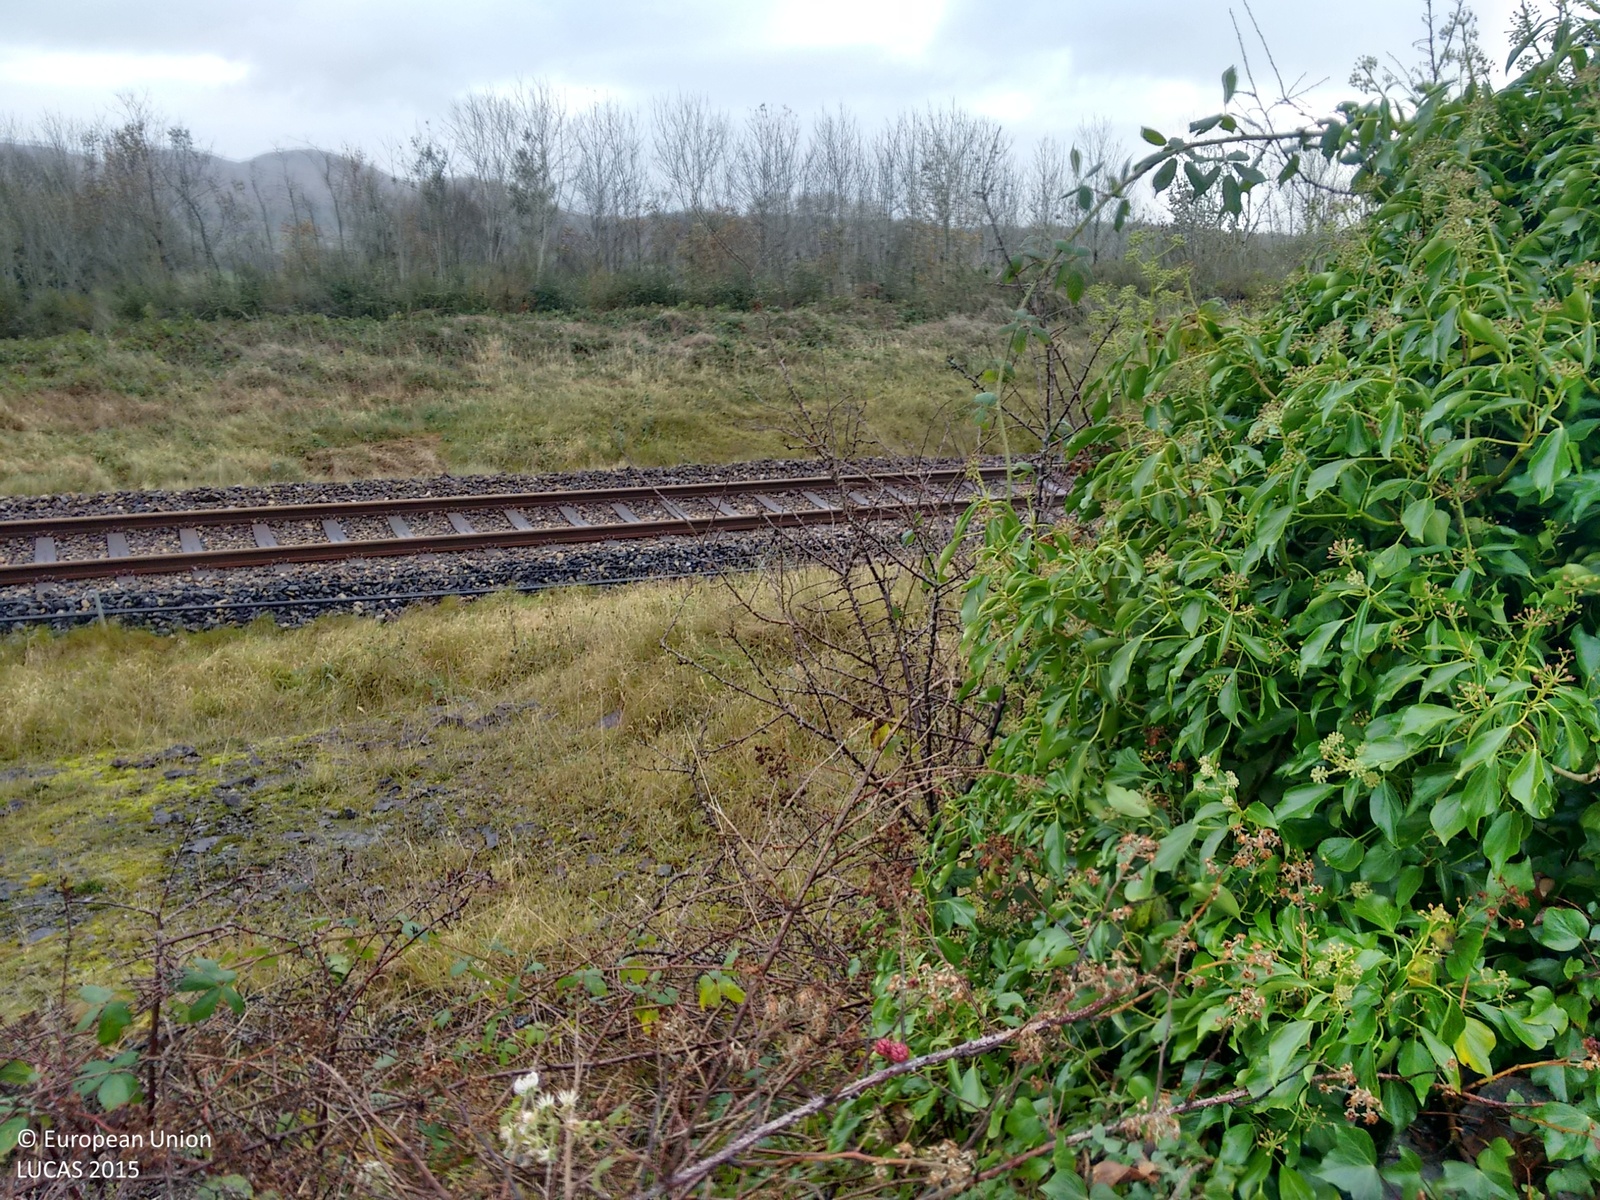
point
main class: Grassland
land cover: Grassland without tree/shrub cover
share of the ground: > 75 %
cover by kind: herbaceous plants 100 %
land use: Railway transport
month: November
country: IE
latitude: 54.2325
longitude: -8.4938
